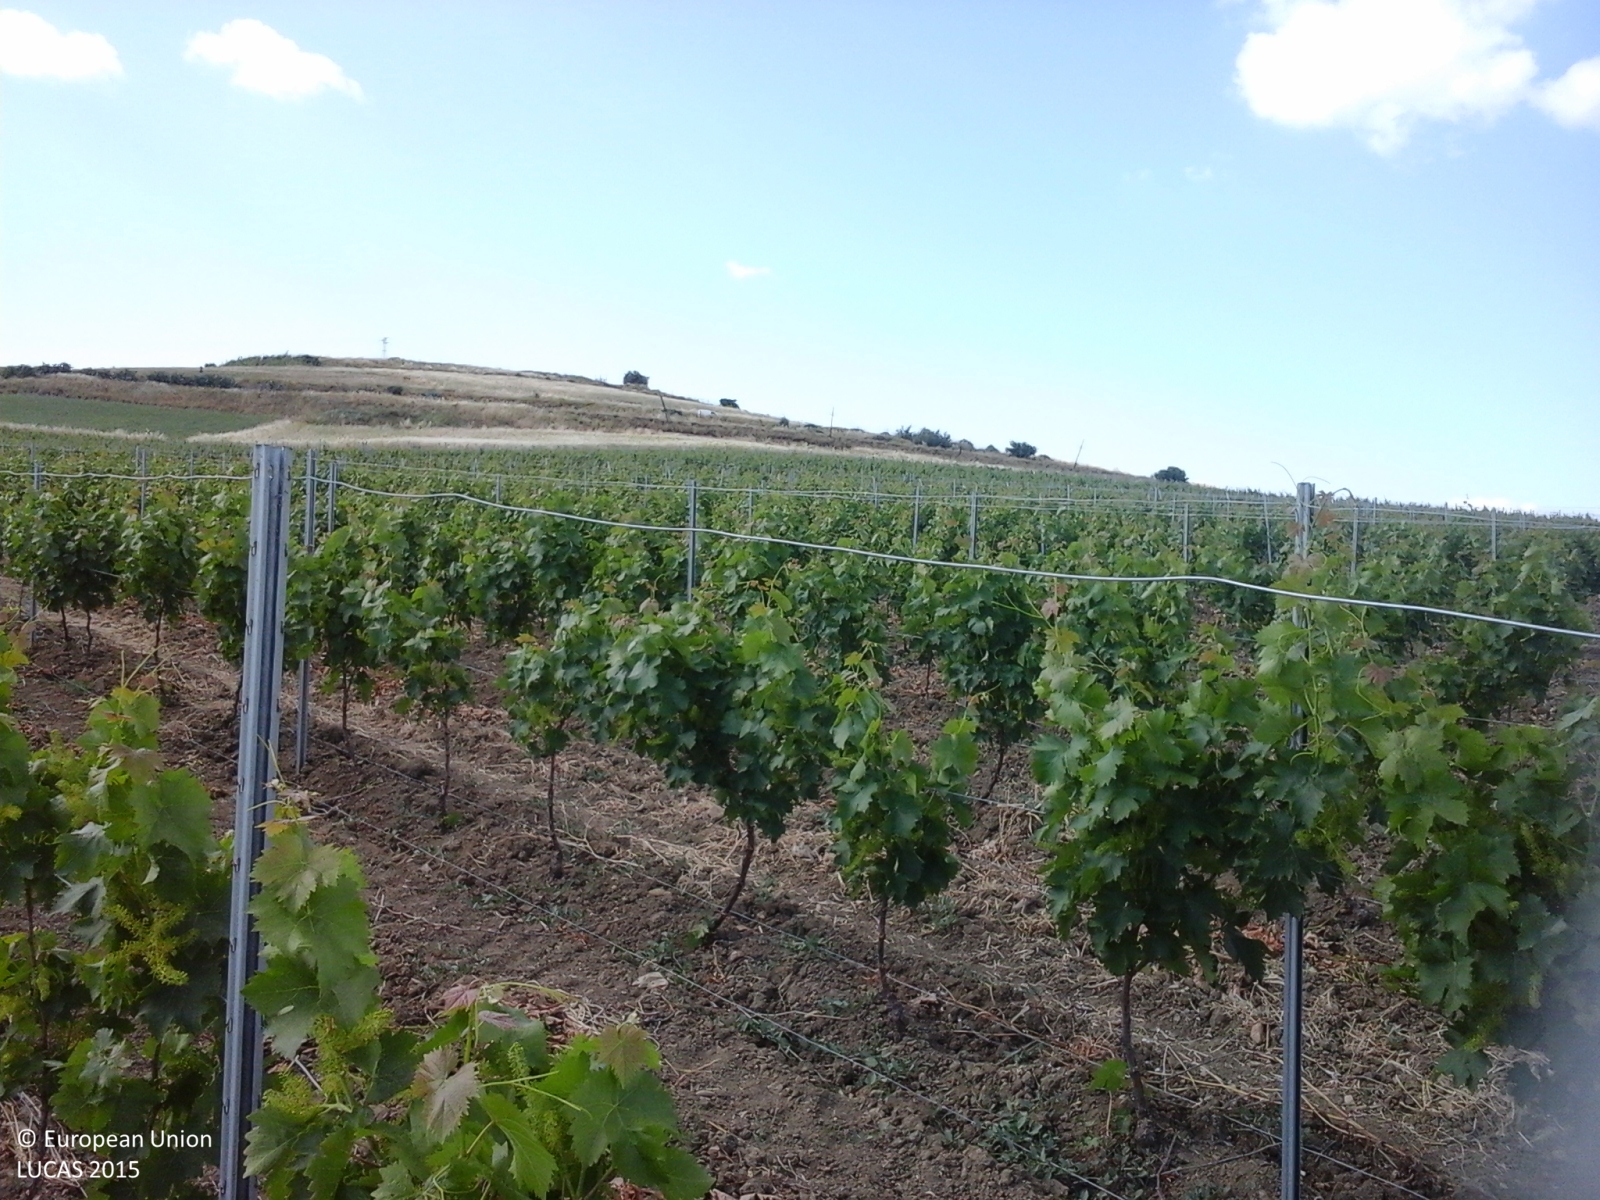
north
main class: Cropland
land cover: Vineyards
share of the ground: 10 - 25 %
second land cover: Other bare soil
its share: > 75 %
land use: Agriculture (excluding fallow land and kitchen gardens)
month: May
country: IT
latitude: 37.5919
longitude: 12.9785
